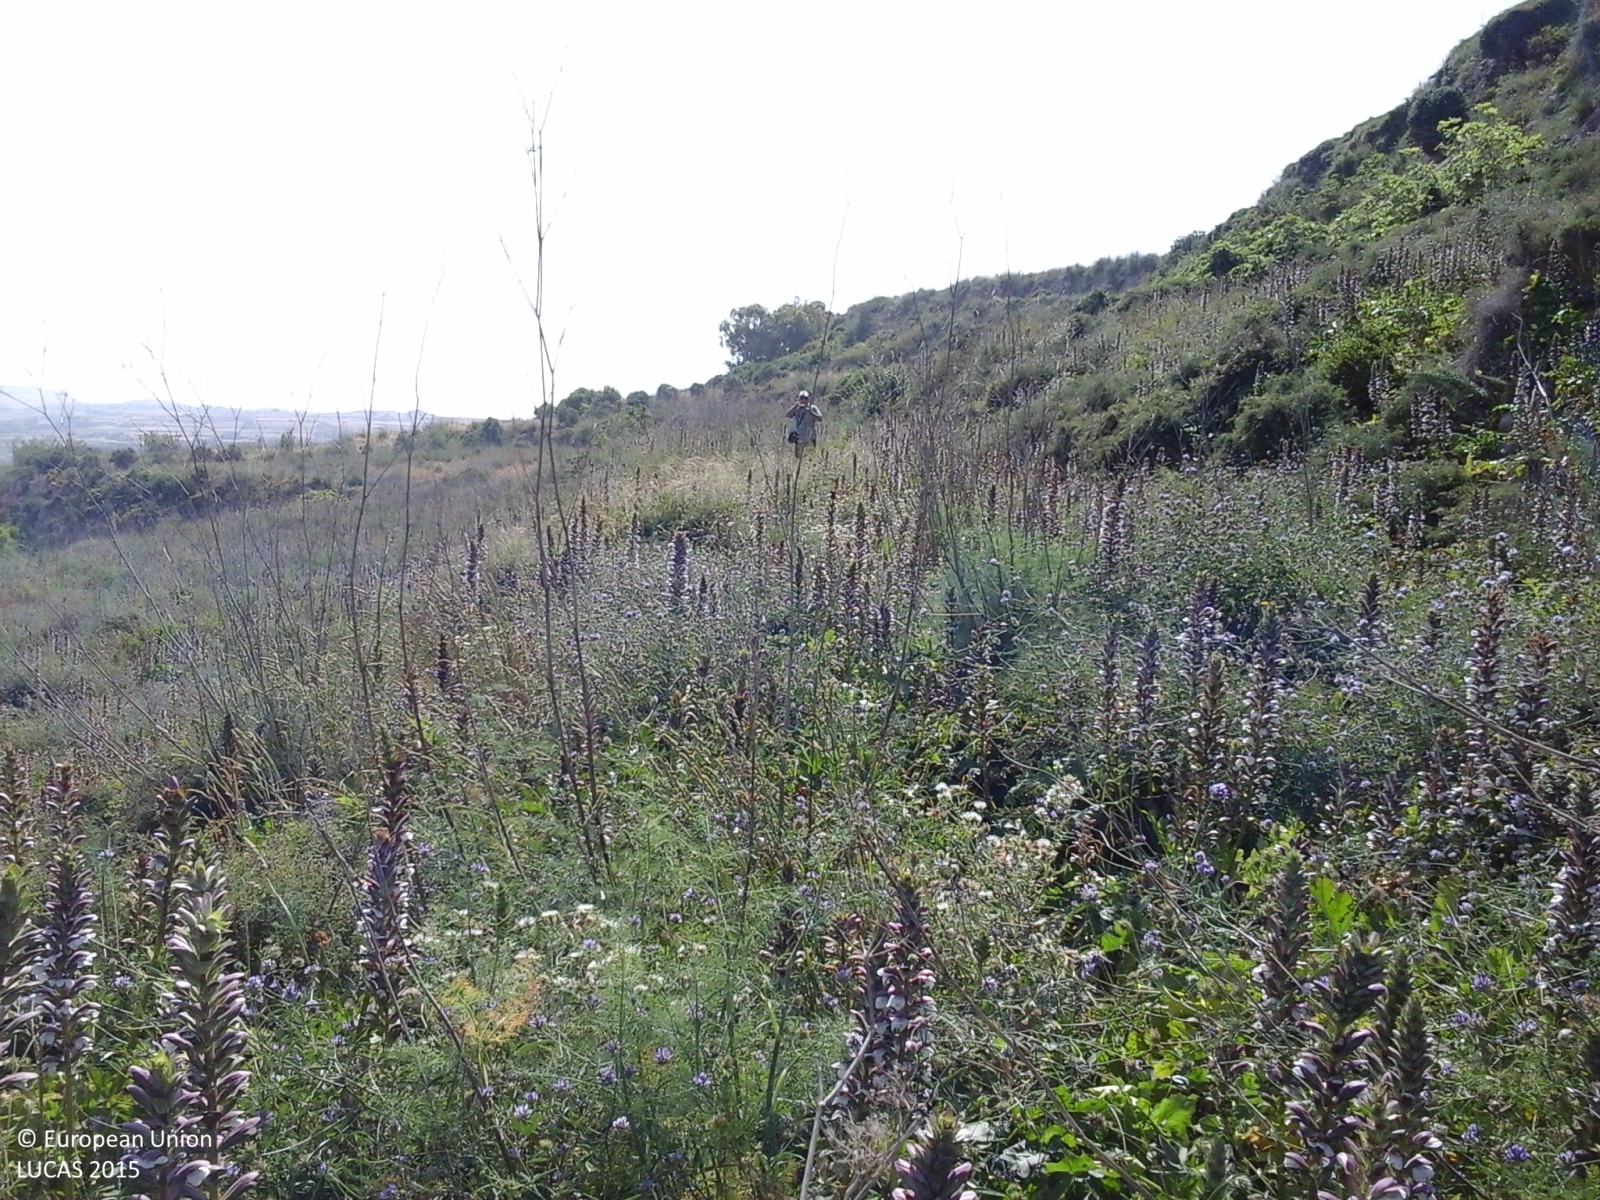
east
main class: Shrubland
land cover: Shrubland without tree cover
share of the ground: > 75 %
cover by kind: shrubs 70 %, herbaceous plants 30 %
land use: Semi-natural and natural areas not in use
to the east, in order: Shrubland without tree cover; Lines of trees; Grassland without tree/shrub cover; Shruby margins; Dry stone walls; Triticale; Shrubland without tree cover
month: May
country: MT
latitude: 35.9350
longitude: 14.4043
